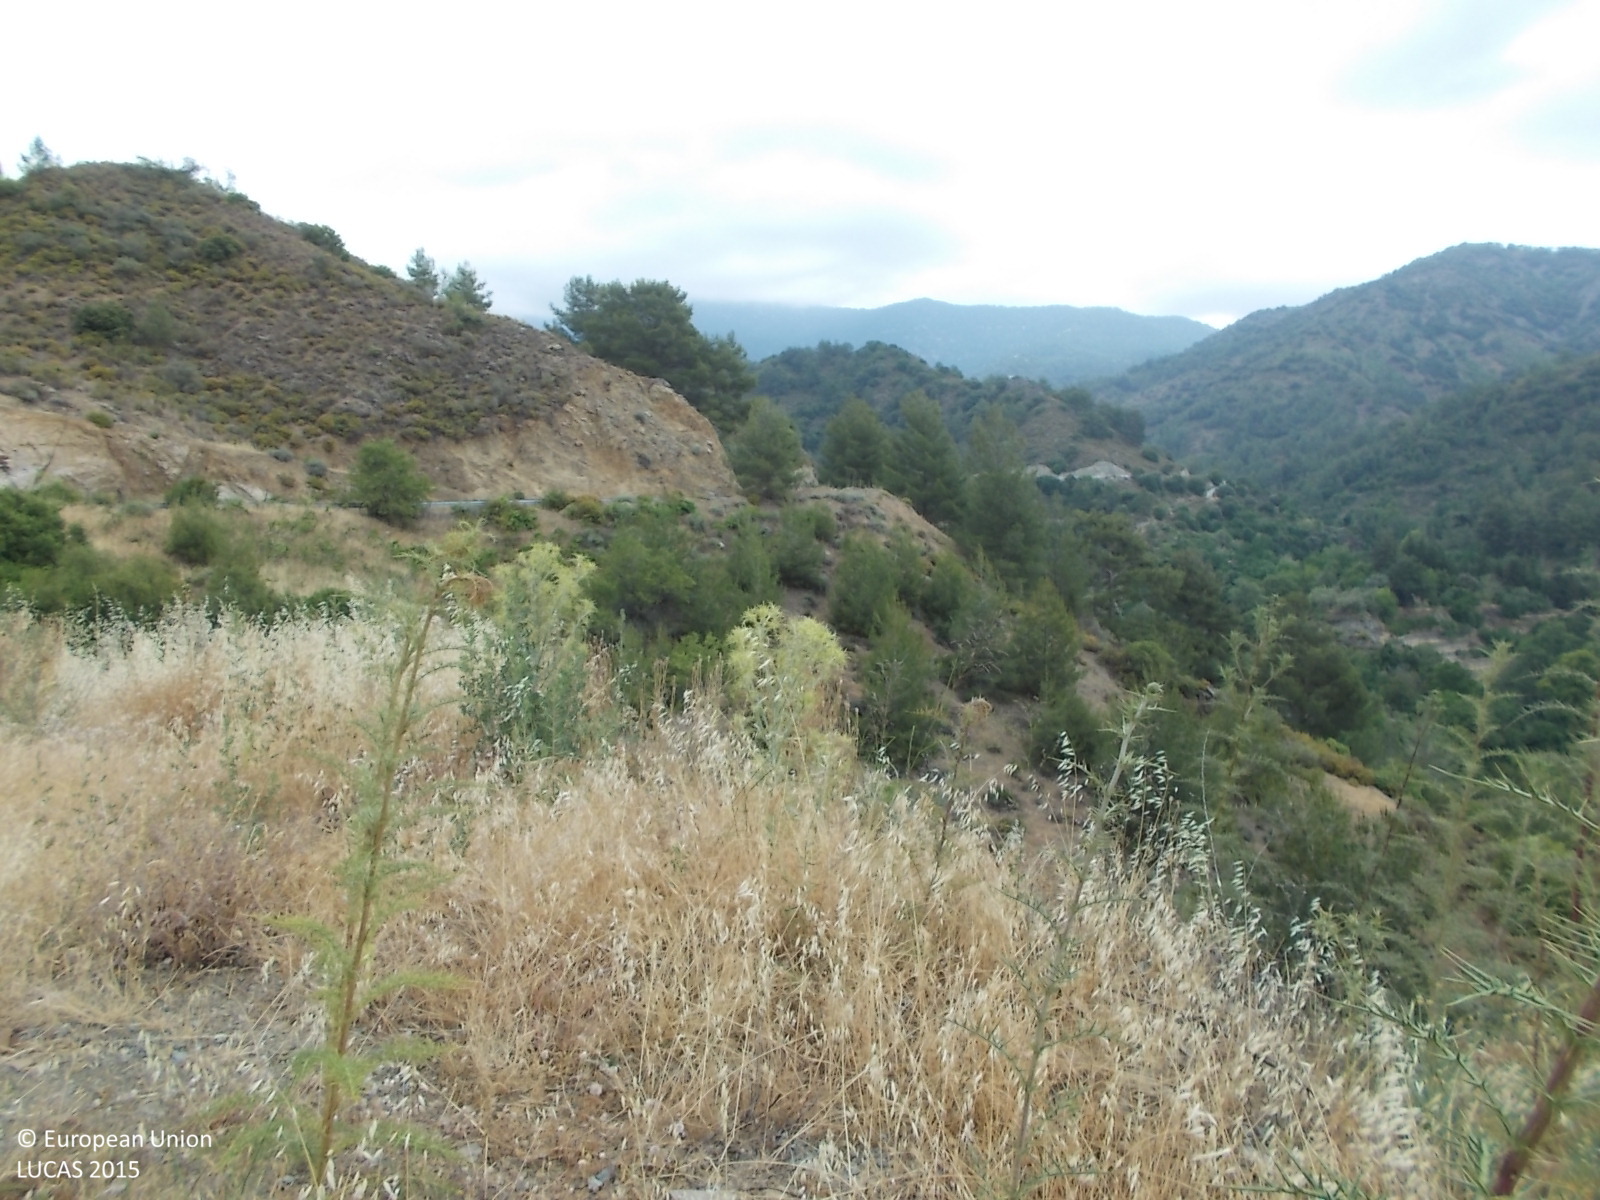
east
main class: Woodland
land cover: Pine dominated coniferous woodland
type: coniferous forest of the mediterranean region
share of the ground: 10 - 25 %
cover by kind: shrubs 35 %, coniferous forest trees 25 %, unconsolidated bare surface 25 %, herbaceous plants 15 %
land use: Forestry
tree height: > 5 m
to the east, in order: Pine dominated coniferous woodland; Shrubland without tree cover; Pine dominated coniferous woodland
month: June
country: CY
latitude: 34.9225
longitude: 32.7895
